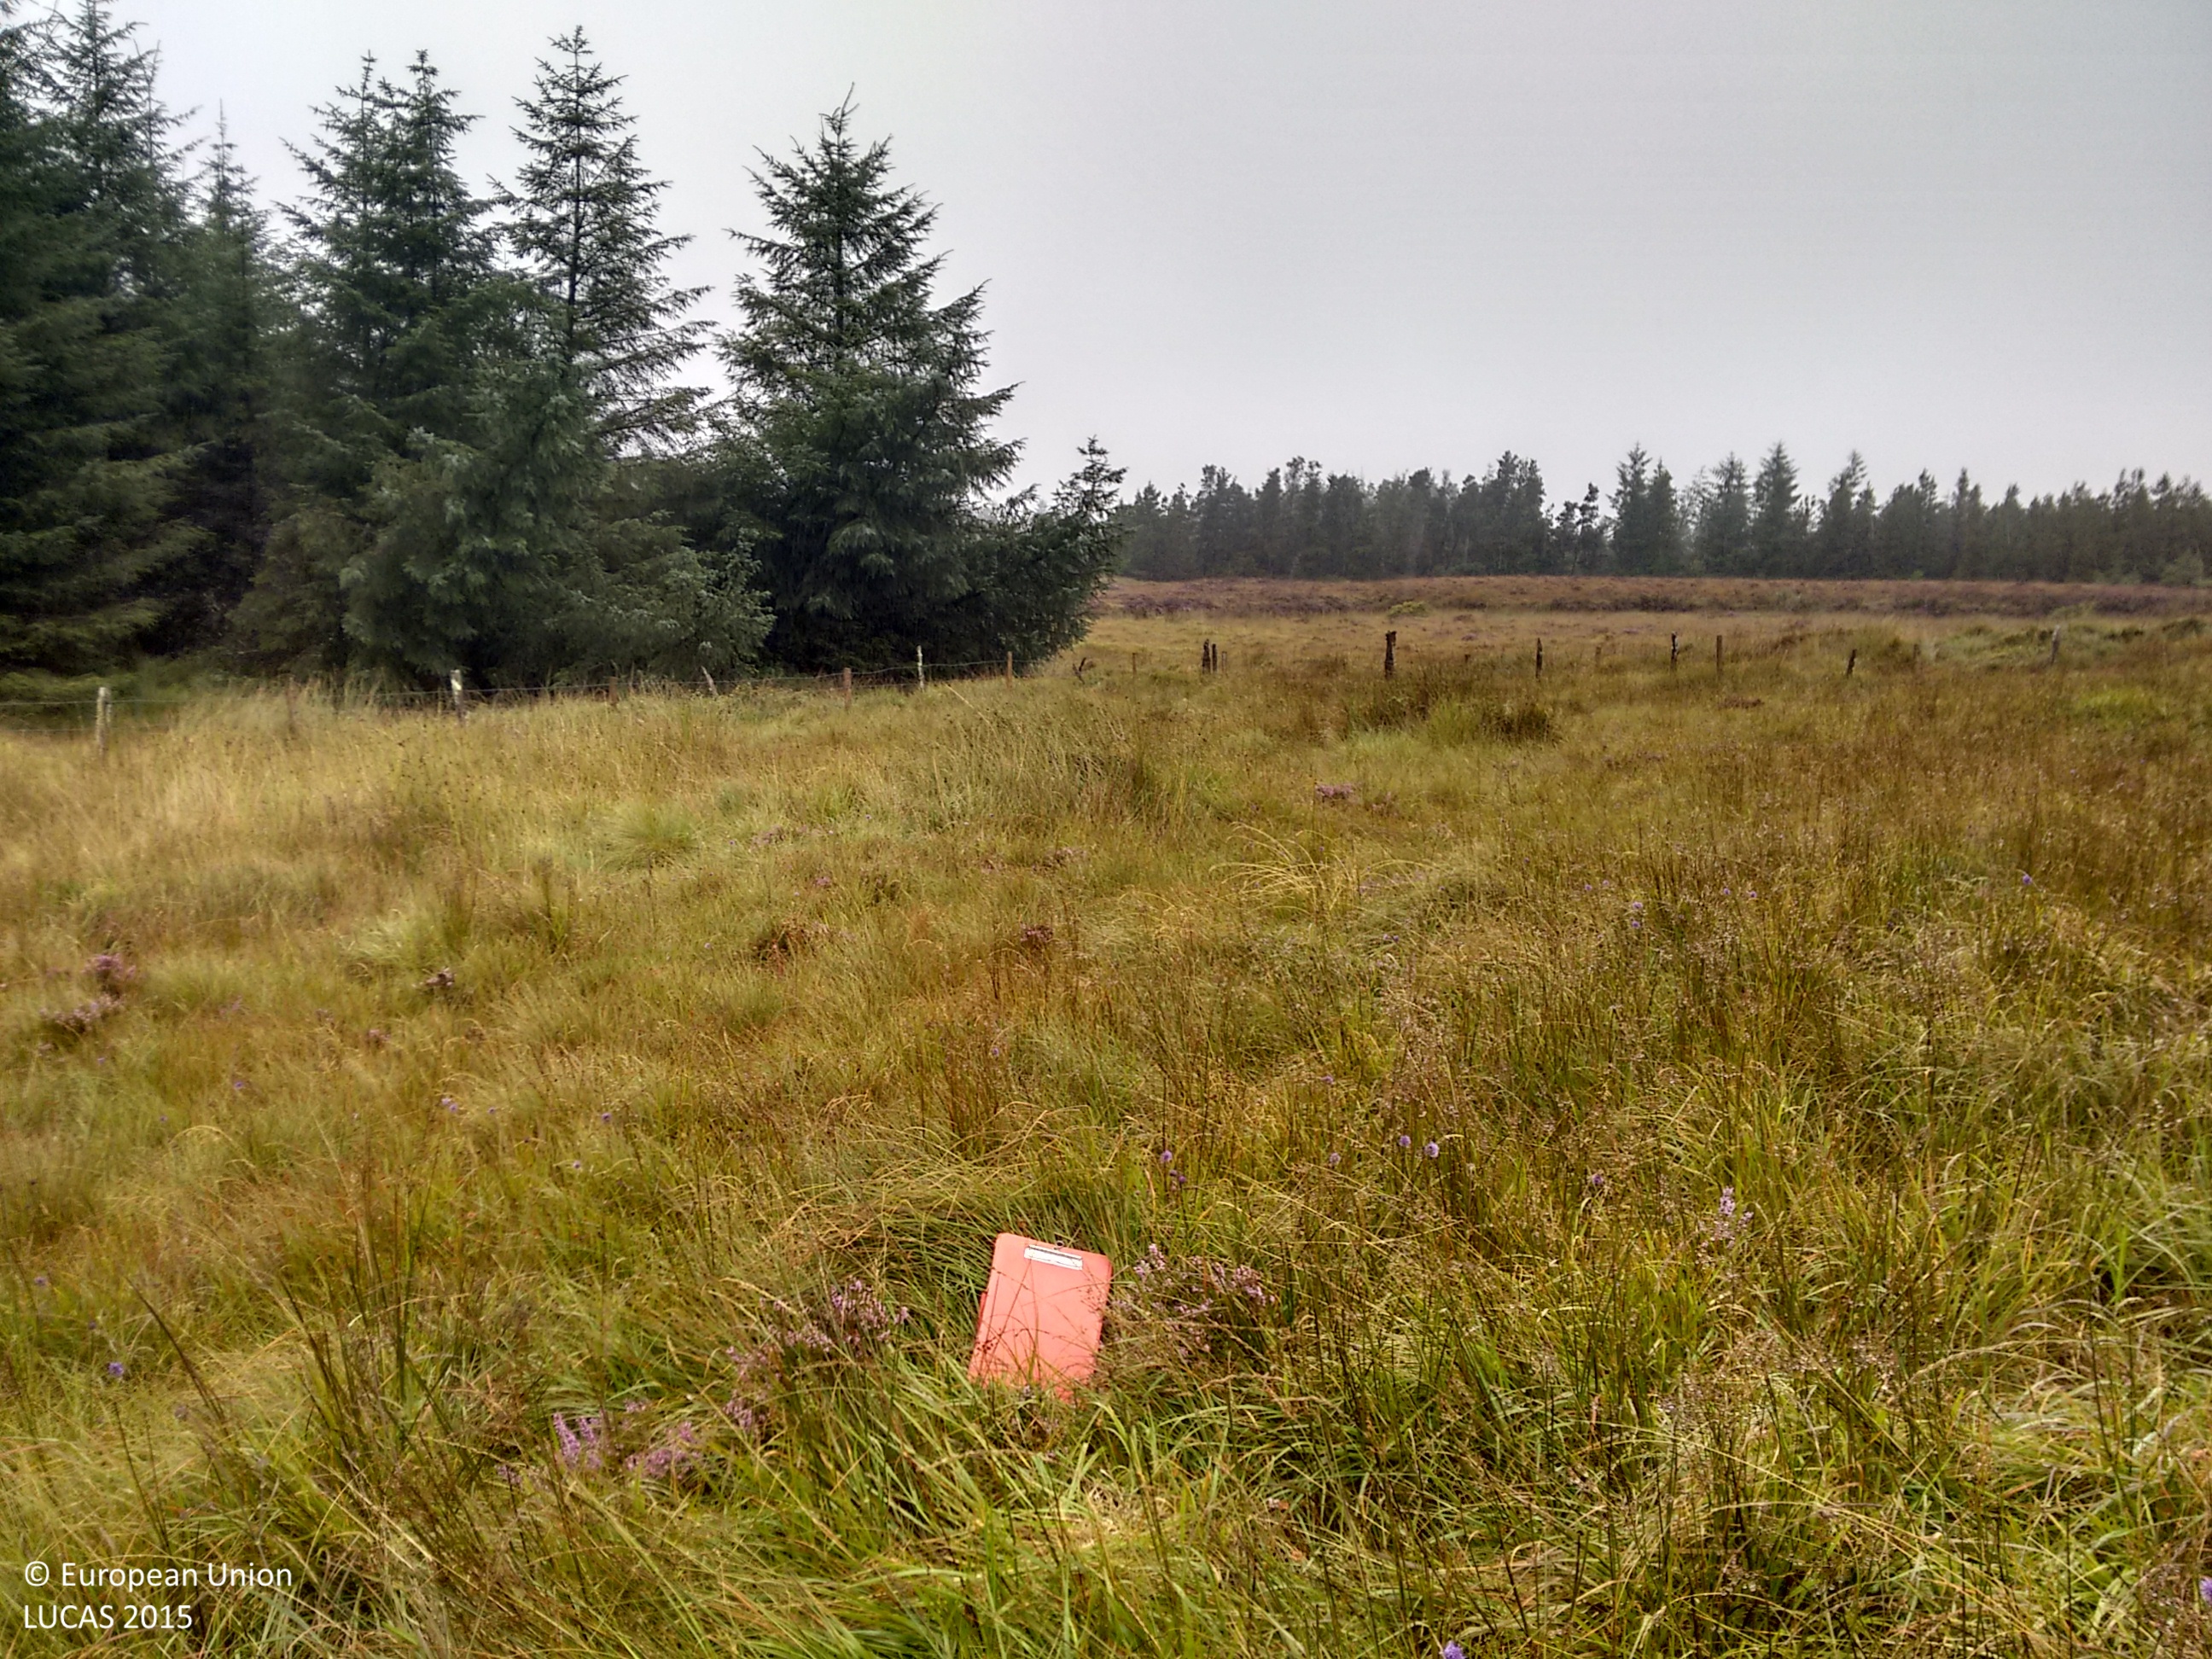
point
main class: Grassland
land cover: Grassland without tree/shrub cover
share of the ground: > 75 %
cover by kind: herbaceous plants 100 %
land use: Agriculture (excluding fallow land and kitchen gardens)
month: September
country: IE
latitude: 52.7387
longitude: -8.7007
